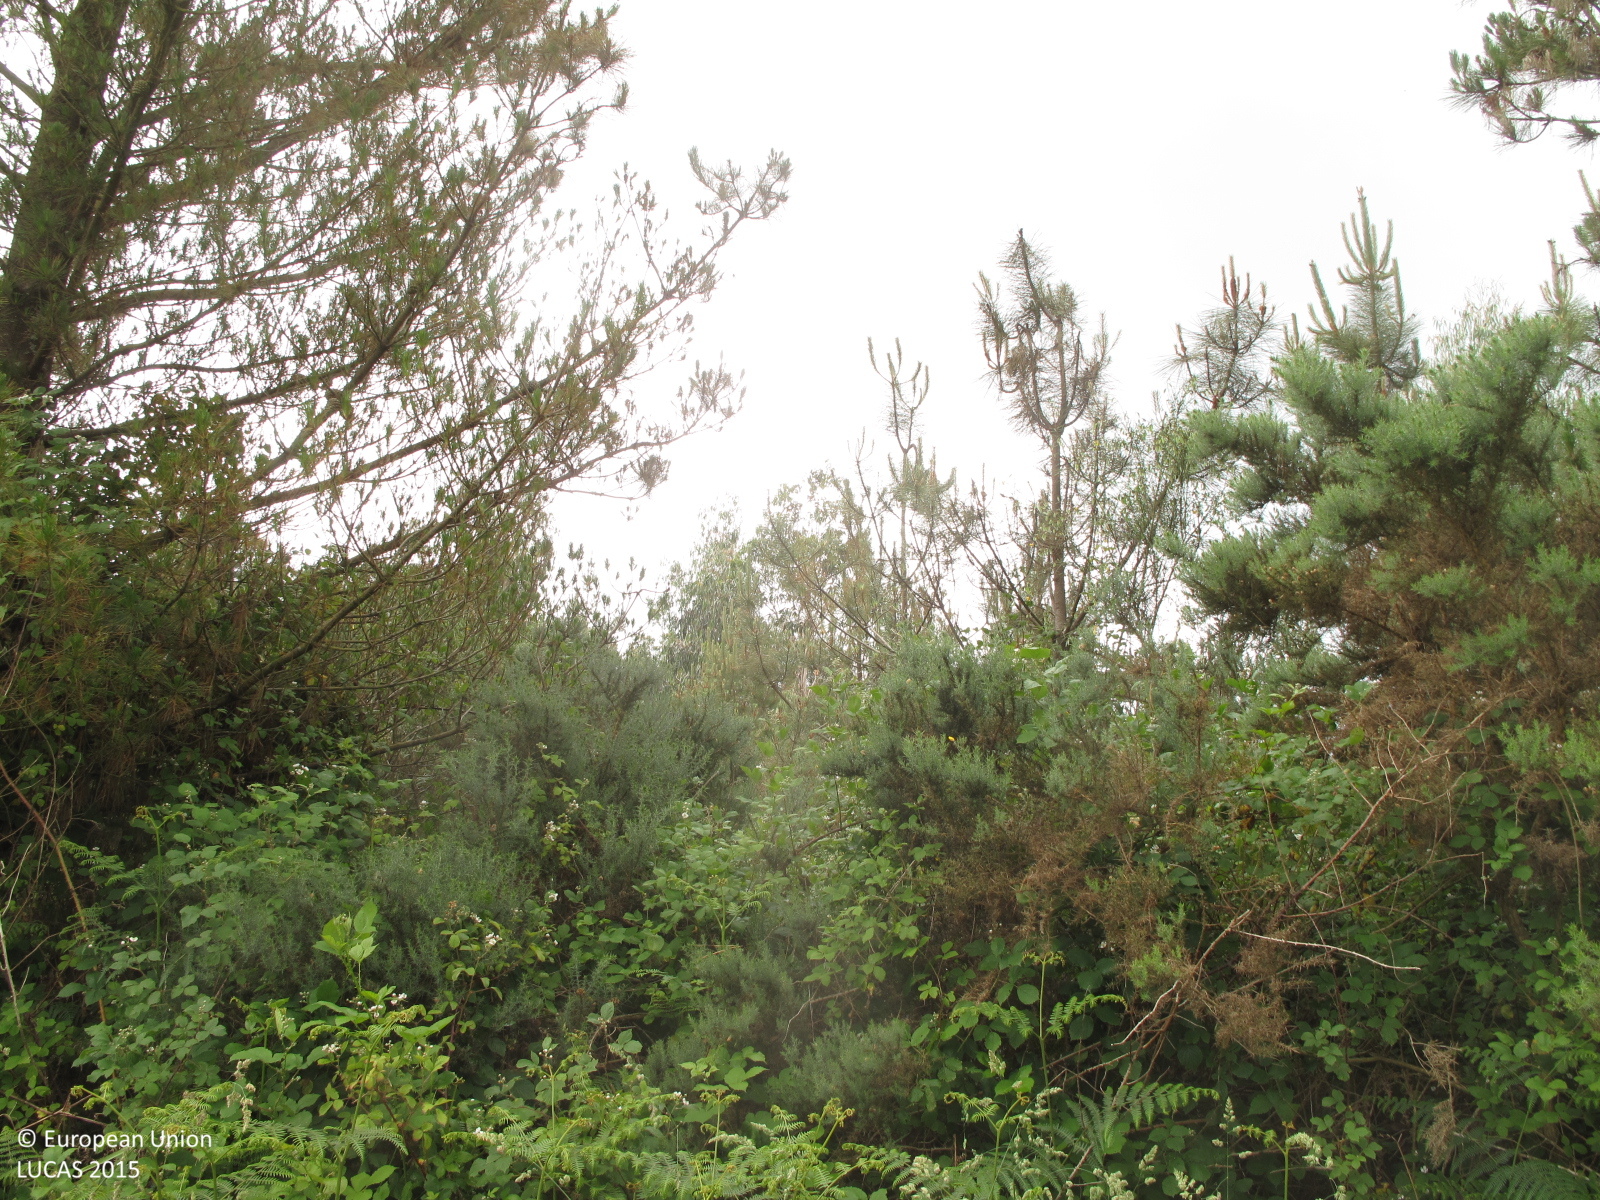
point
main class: Woodland
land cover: Other mixed woodland
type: exotic forest
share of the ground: 50 - 75 %
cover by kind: shrubs 40 %, broadleaved forest trees 30 %, coniferous forest trees 20 %, herbaceous plants 10 %
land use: Forestry
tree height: > 5 m
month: June
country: ES
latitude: 43.1159
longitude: -8.5808
